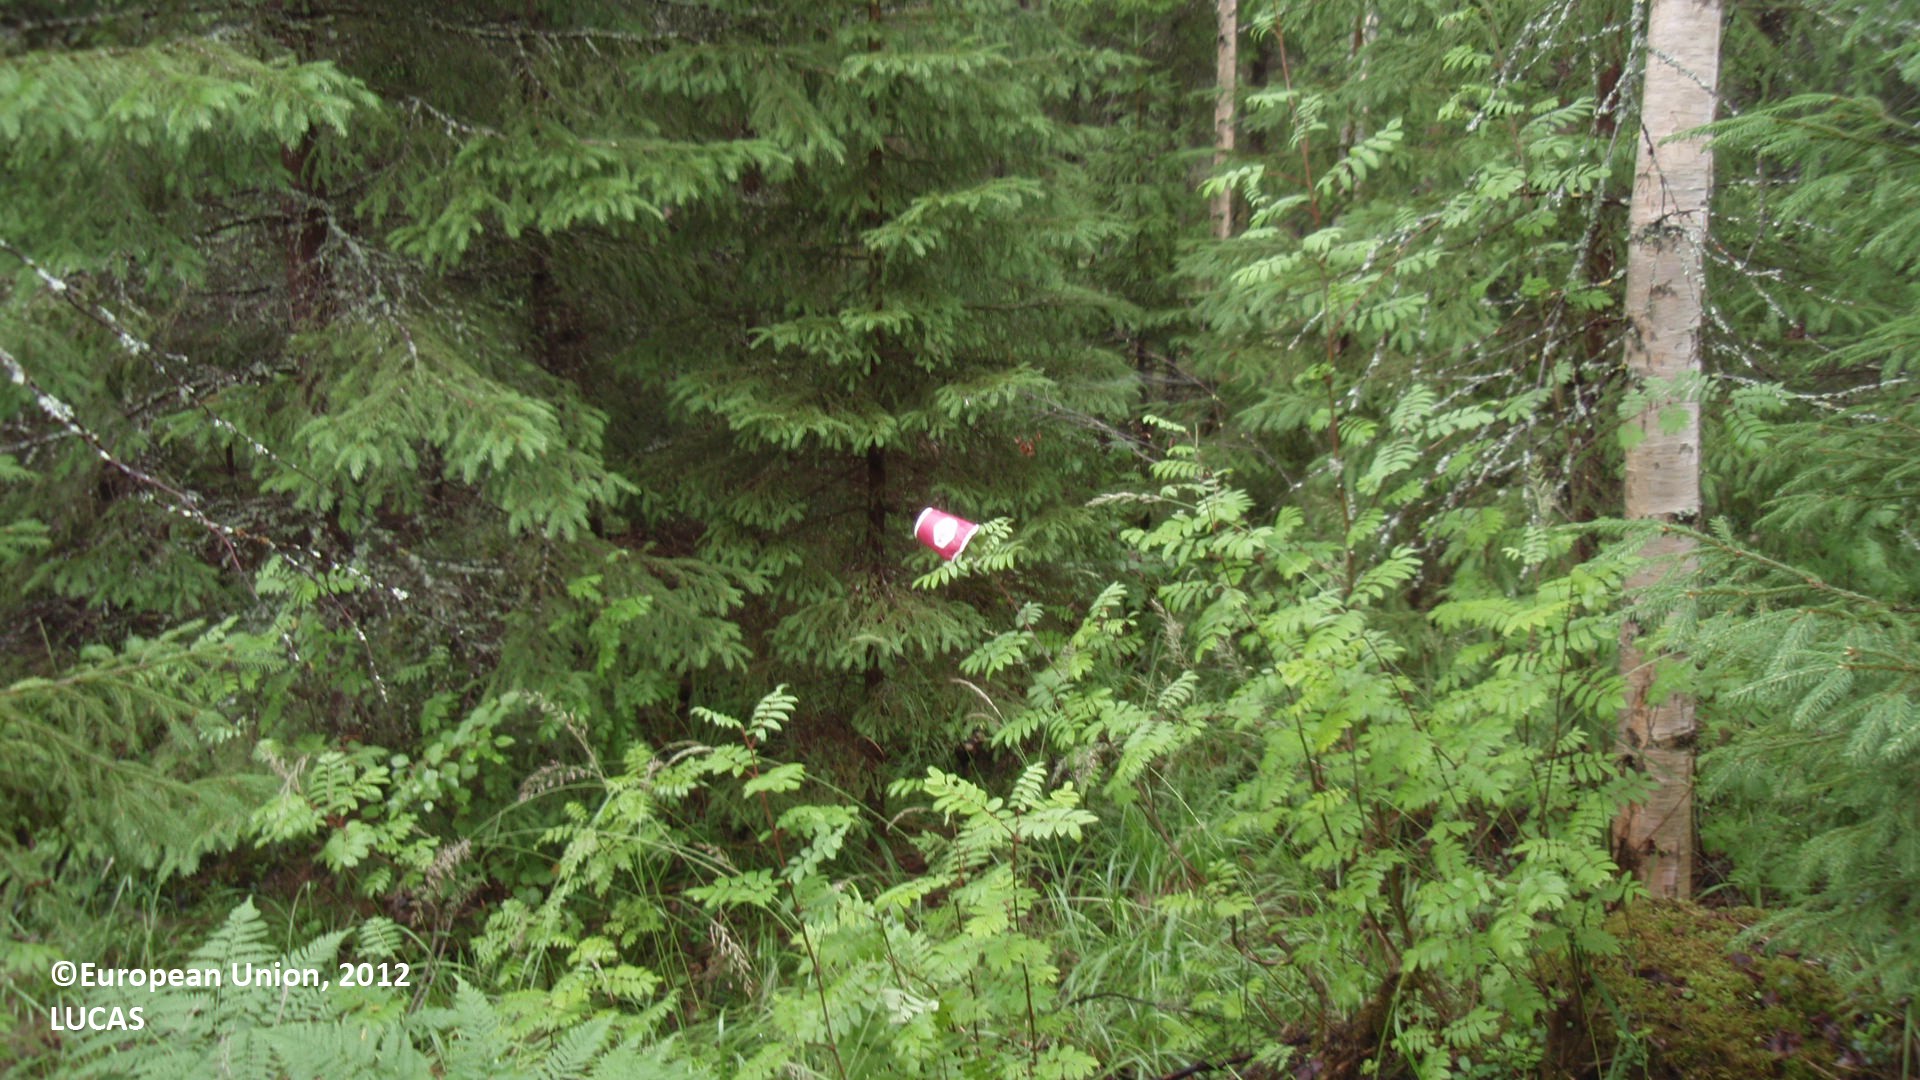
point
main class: Woodland
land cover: Spruce dominated mixed woodland
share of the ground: > 75 %
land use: Forestry
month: July
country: FI
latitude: 61.5852
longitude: 27.2553
